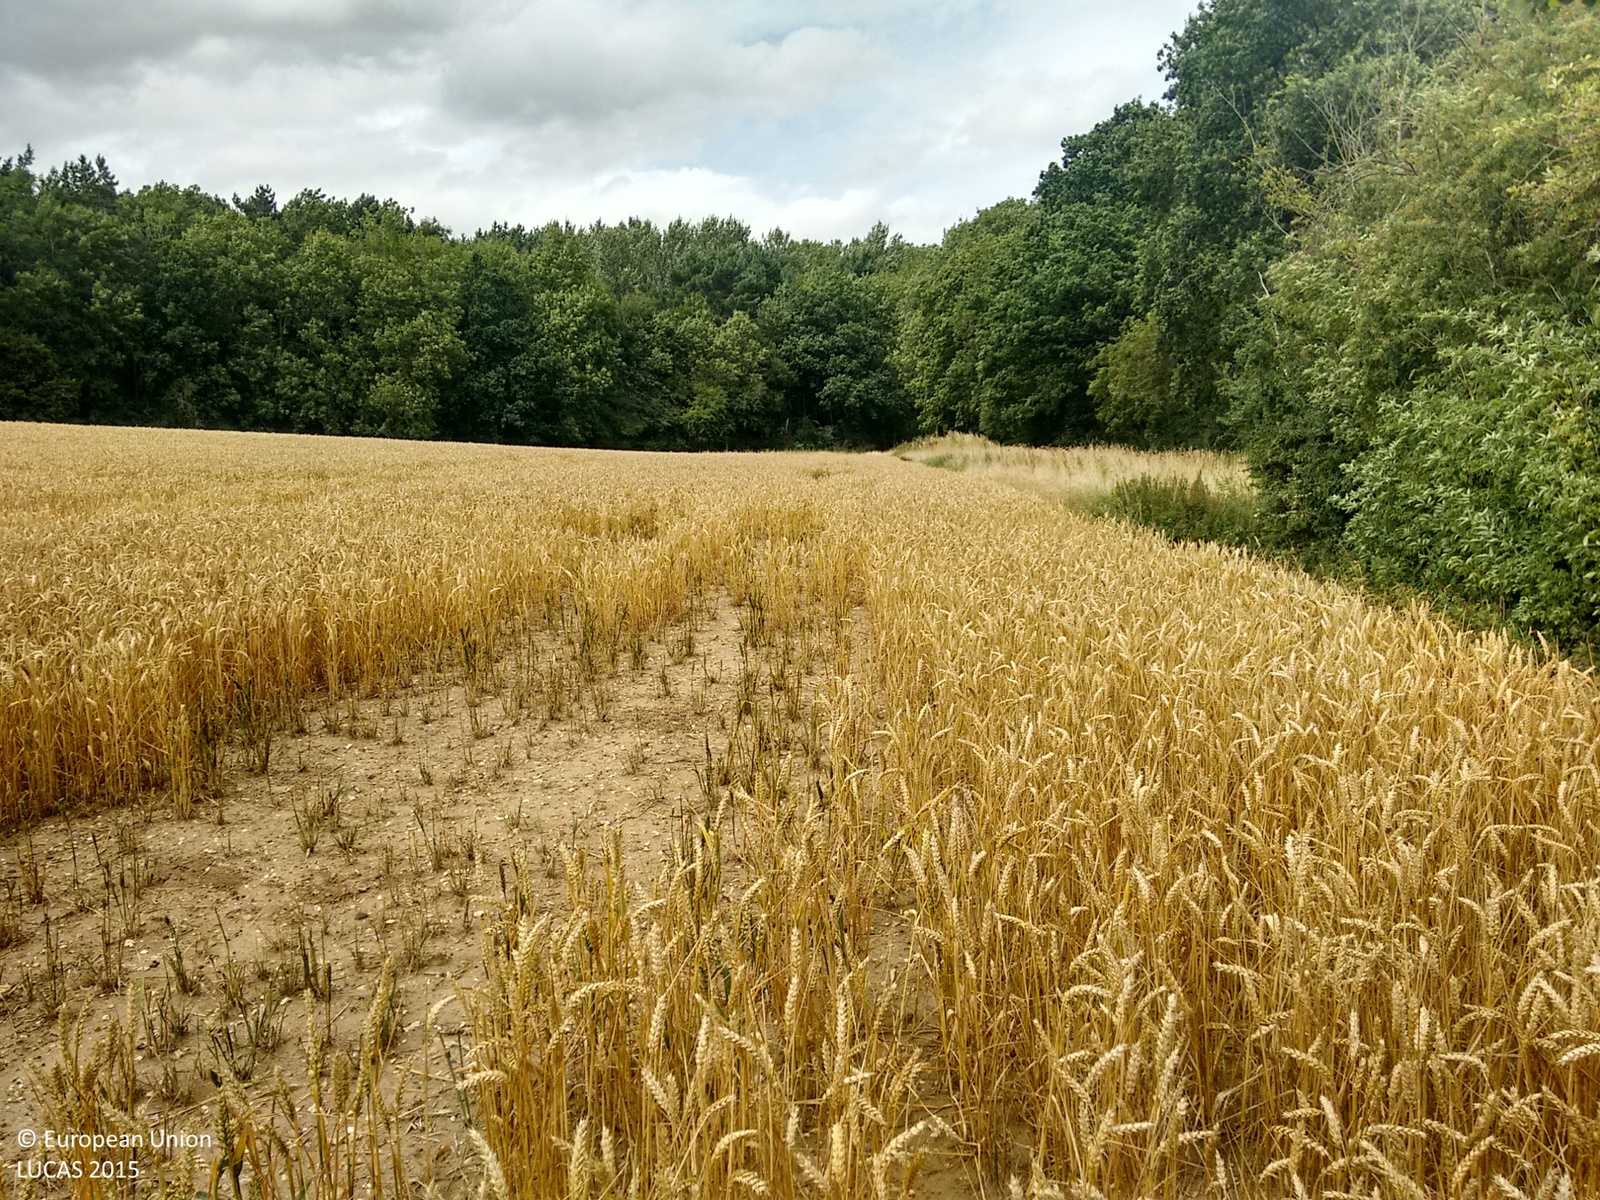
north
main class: Cropland
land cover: Common wheat
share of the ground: 50 - 75 %
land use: Agriculture (excluding fallow land and kitchen gardens)
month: August
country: GB
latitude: 51.9594
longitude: 0.4985
